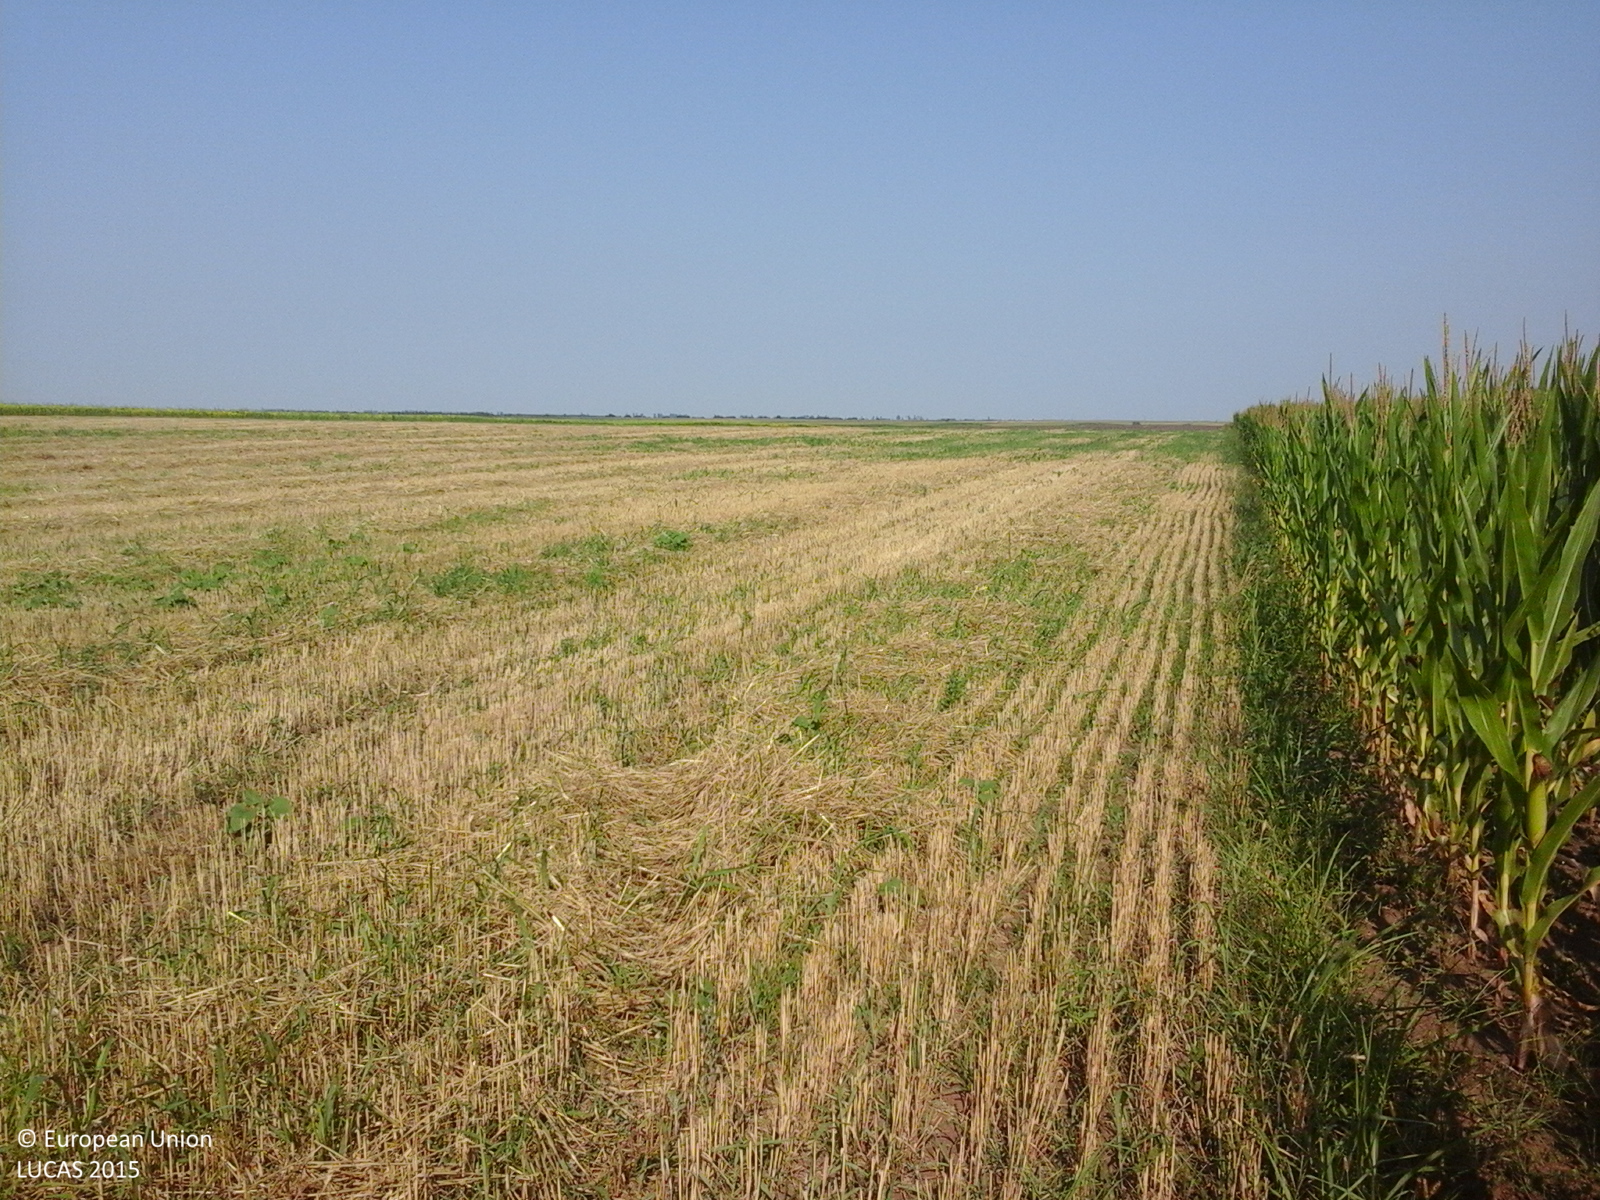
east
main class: Cropland
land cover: Maize
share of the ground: > 75 %
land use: Agriculture (excluding fallow land and kitchen gardens)
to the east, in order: Maize
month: July
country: RO
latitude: 44.8943
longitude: 27.1690
